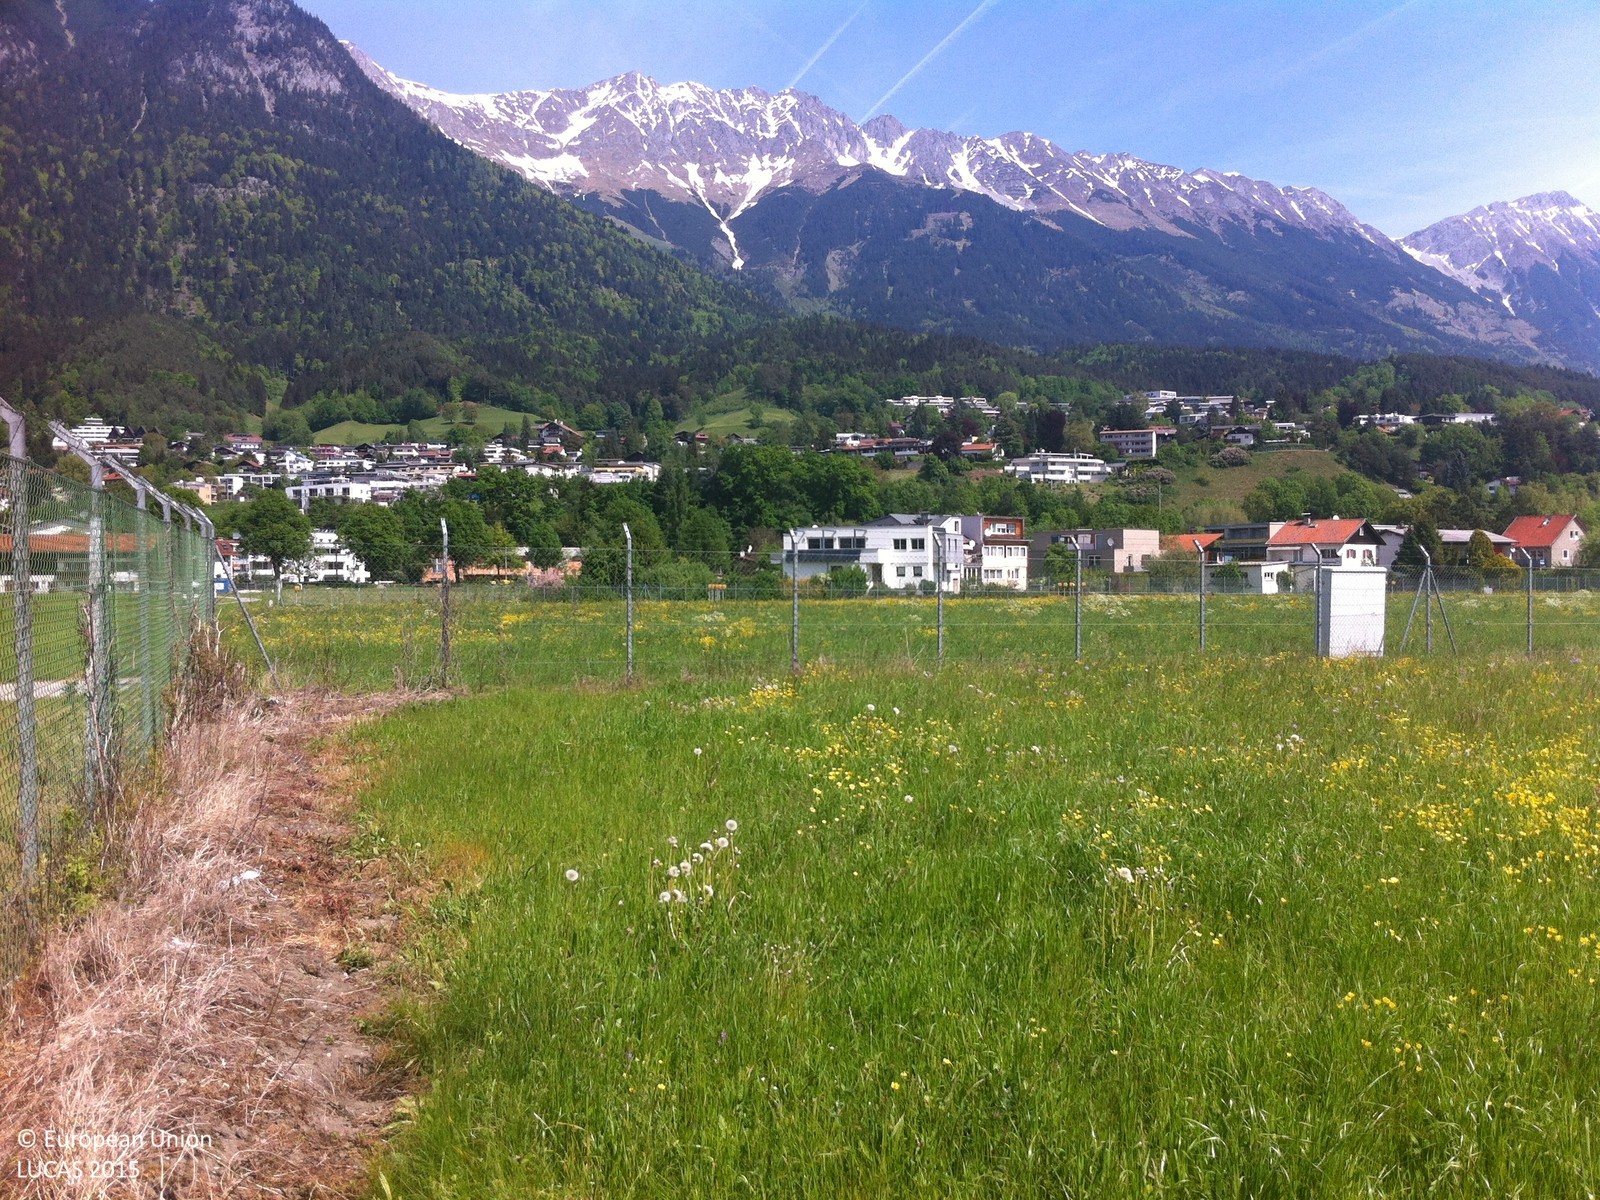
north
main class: Grassland
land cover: Grassland without tree/shrub cover
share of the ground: > 75 %
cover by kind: herbaceous plants 100 %
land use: Air transport
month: May
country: AT
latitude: 47.2611
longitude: 11.3599
